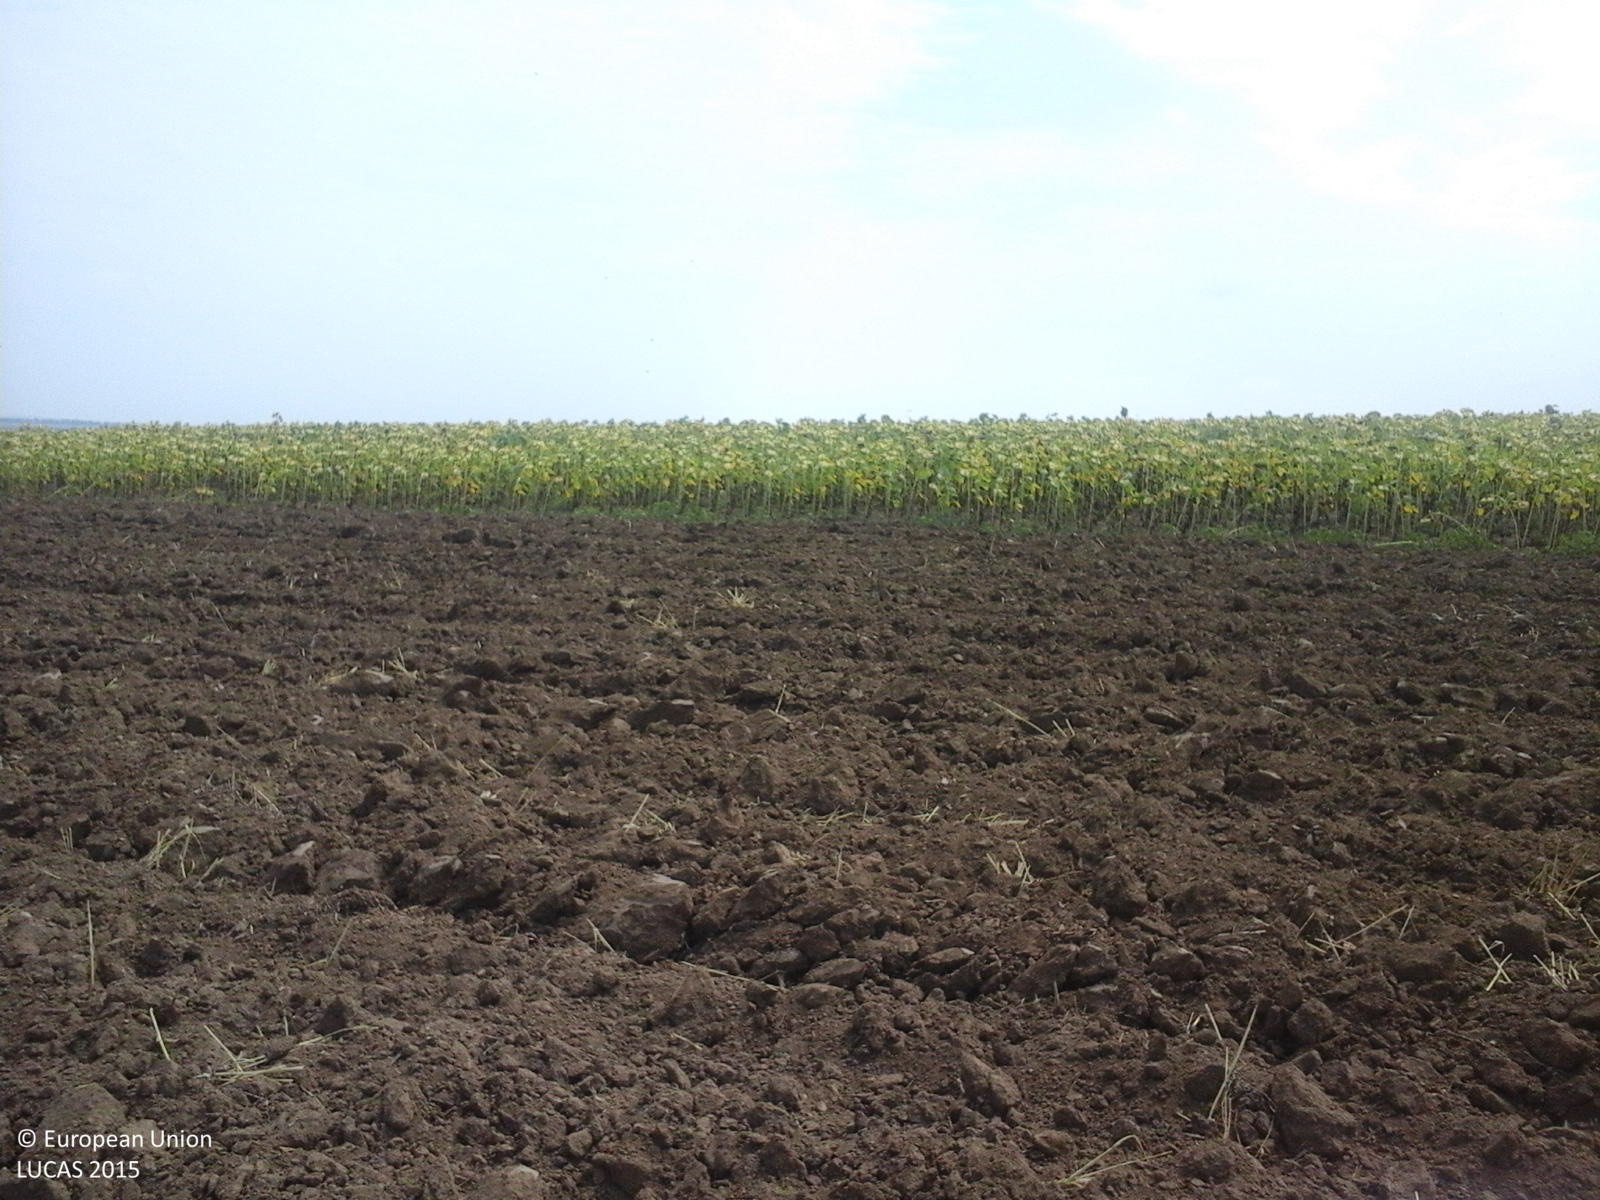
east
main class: Cropland
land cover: Common wheat
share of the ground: < 10 %
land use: Agriculture (excluding fallow land and kitchen gardens)
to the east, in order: Common wheat; Sunflower; Maize
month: August
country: RO
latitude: 44.8929
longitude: 28.7628
